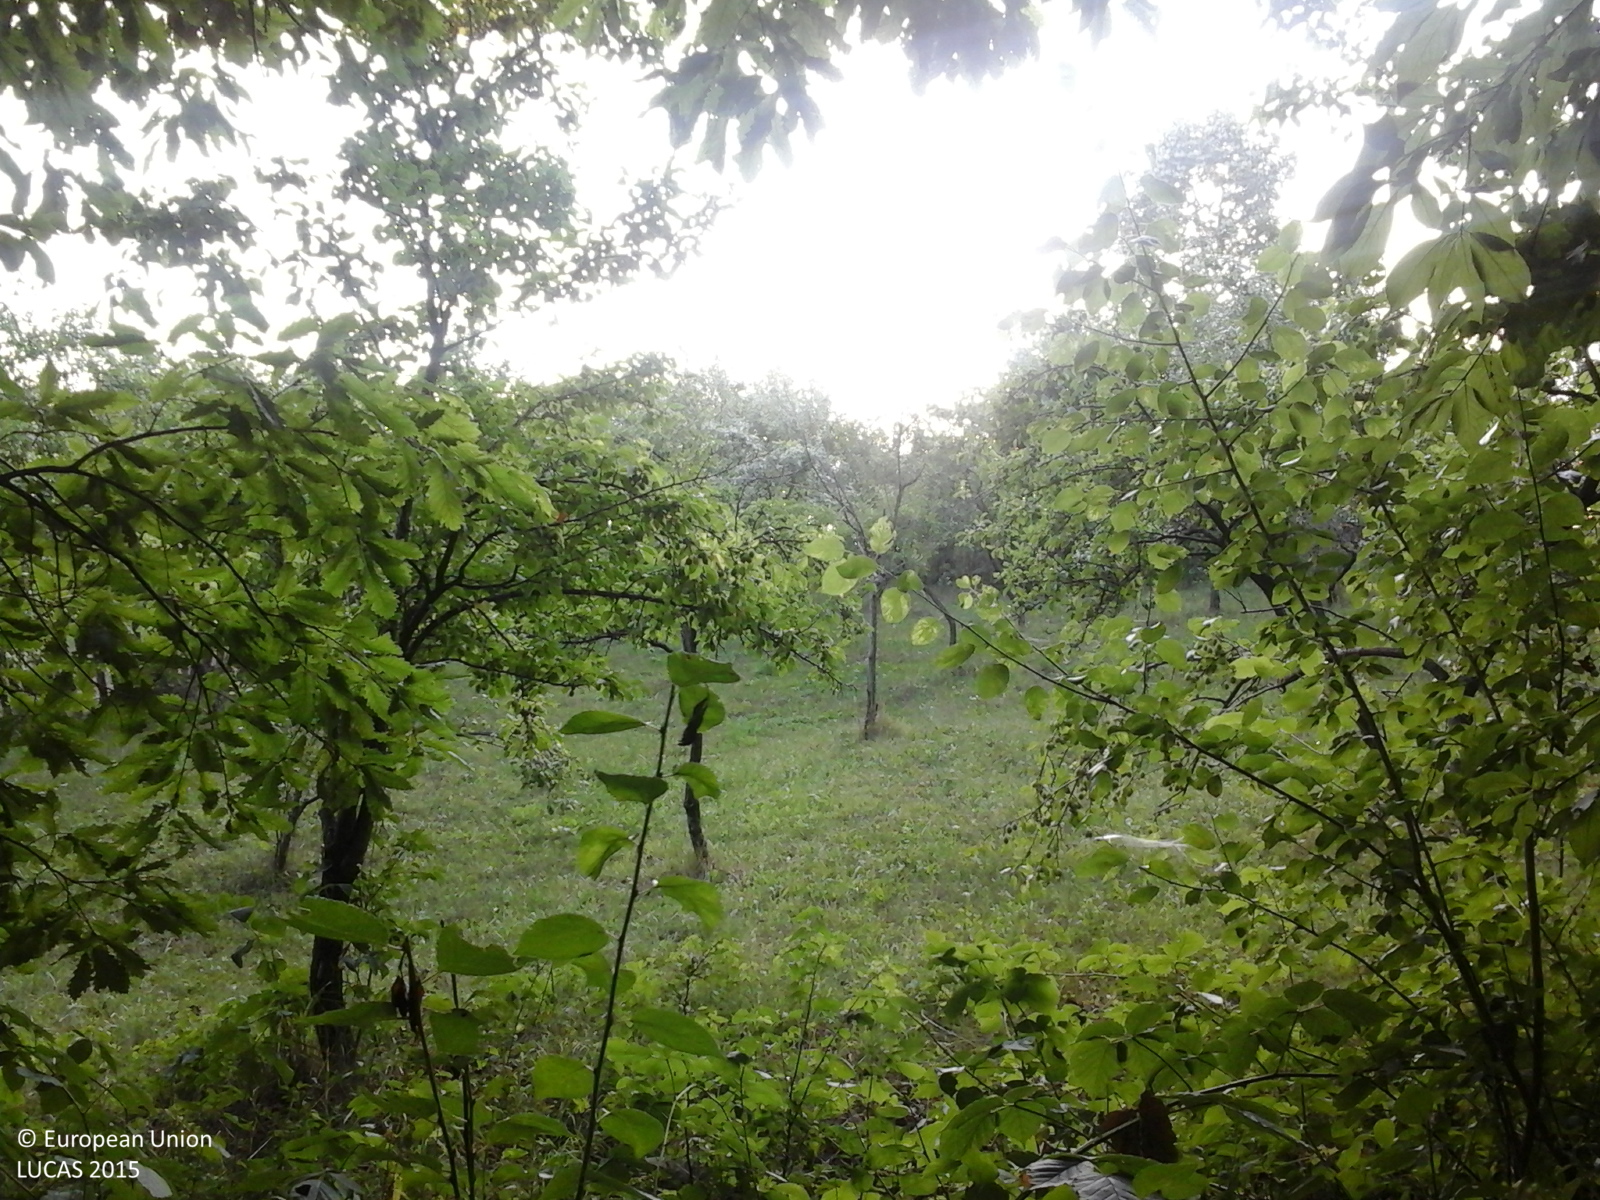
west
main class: Cropland
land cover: Other fruit trees and berries
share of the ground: 50 - 75 %
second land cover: Grassland without tree/shrub cover
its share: > 75 %
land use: Agriculture (excluding fallow land and kitchen gardens)
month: July
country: RO
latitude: 44.8785
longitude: 24.5188
